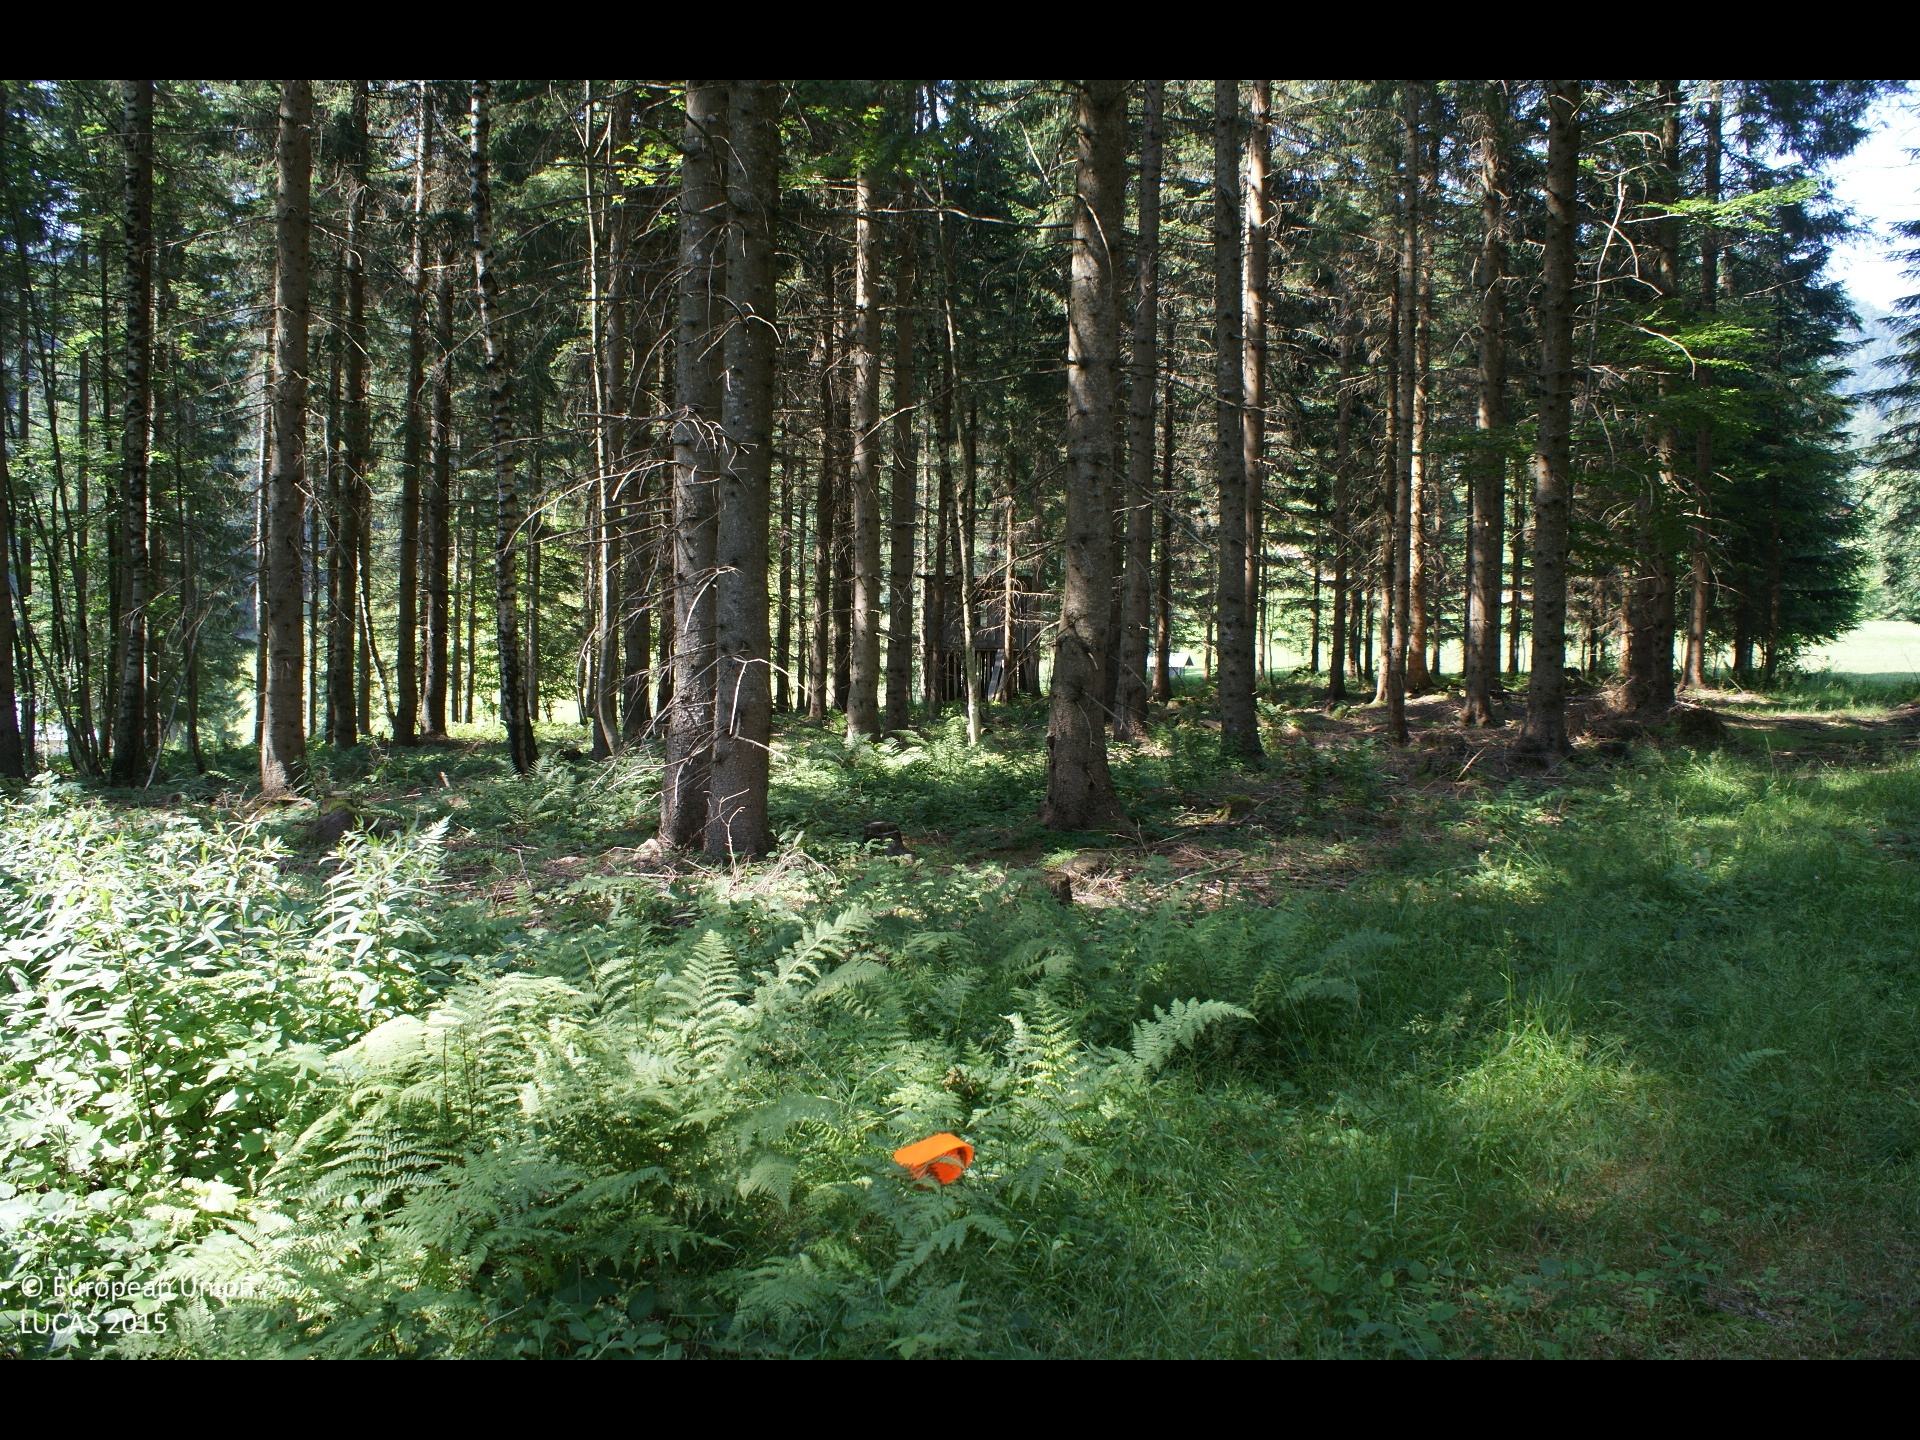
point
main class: Woodland
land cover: Spruce dominated coniferous woodland
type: alpine coniferous forest
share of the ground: > 75 %
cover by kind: coniferous forest trees 70 %, herbaceous plants 15 %, broadleaved forest trees 10 %, shrubs 5 %
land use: Forestry
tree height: > 5 m
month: July
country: AT
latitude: 47.8766
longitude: 15.3631
